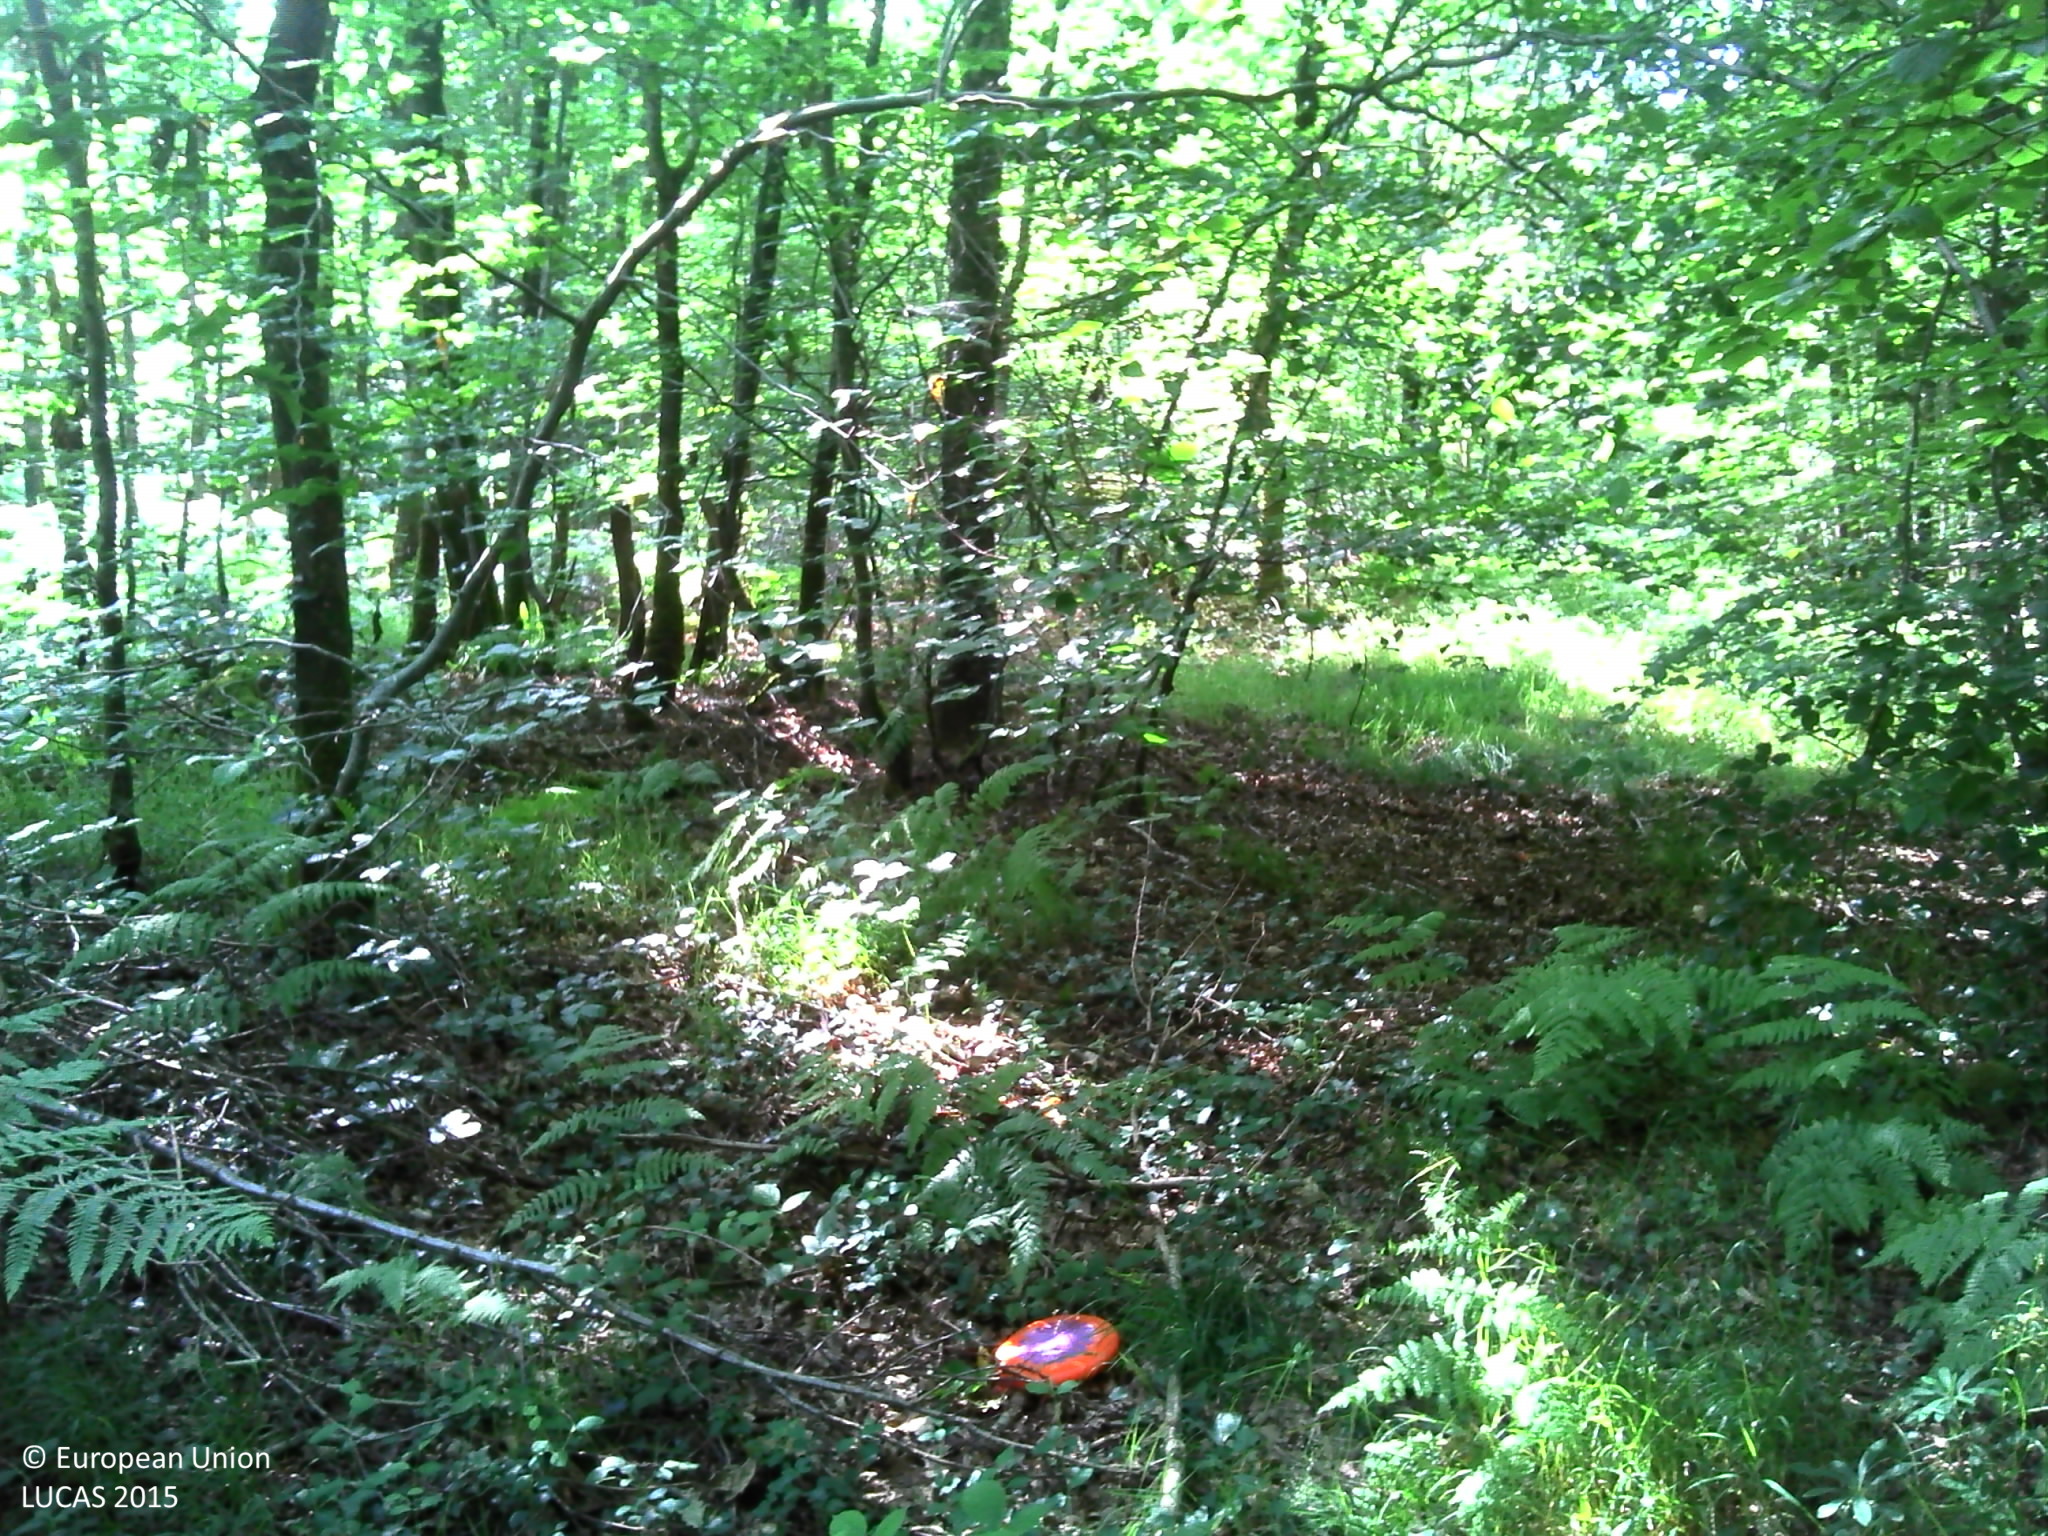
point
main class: Woodland
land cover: Broadleaved woodland
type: beech forest
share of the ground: > 75 %
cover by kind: broadleaved forest trees 75 %, herbaceous plants 15 %, shrubs 10 %
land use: Forestry
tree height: > 5 m
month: June
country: FR
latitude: 48.4051
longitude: 0.2333
